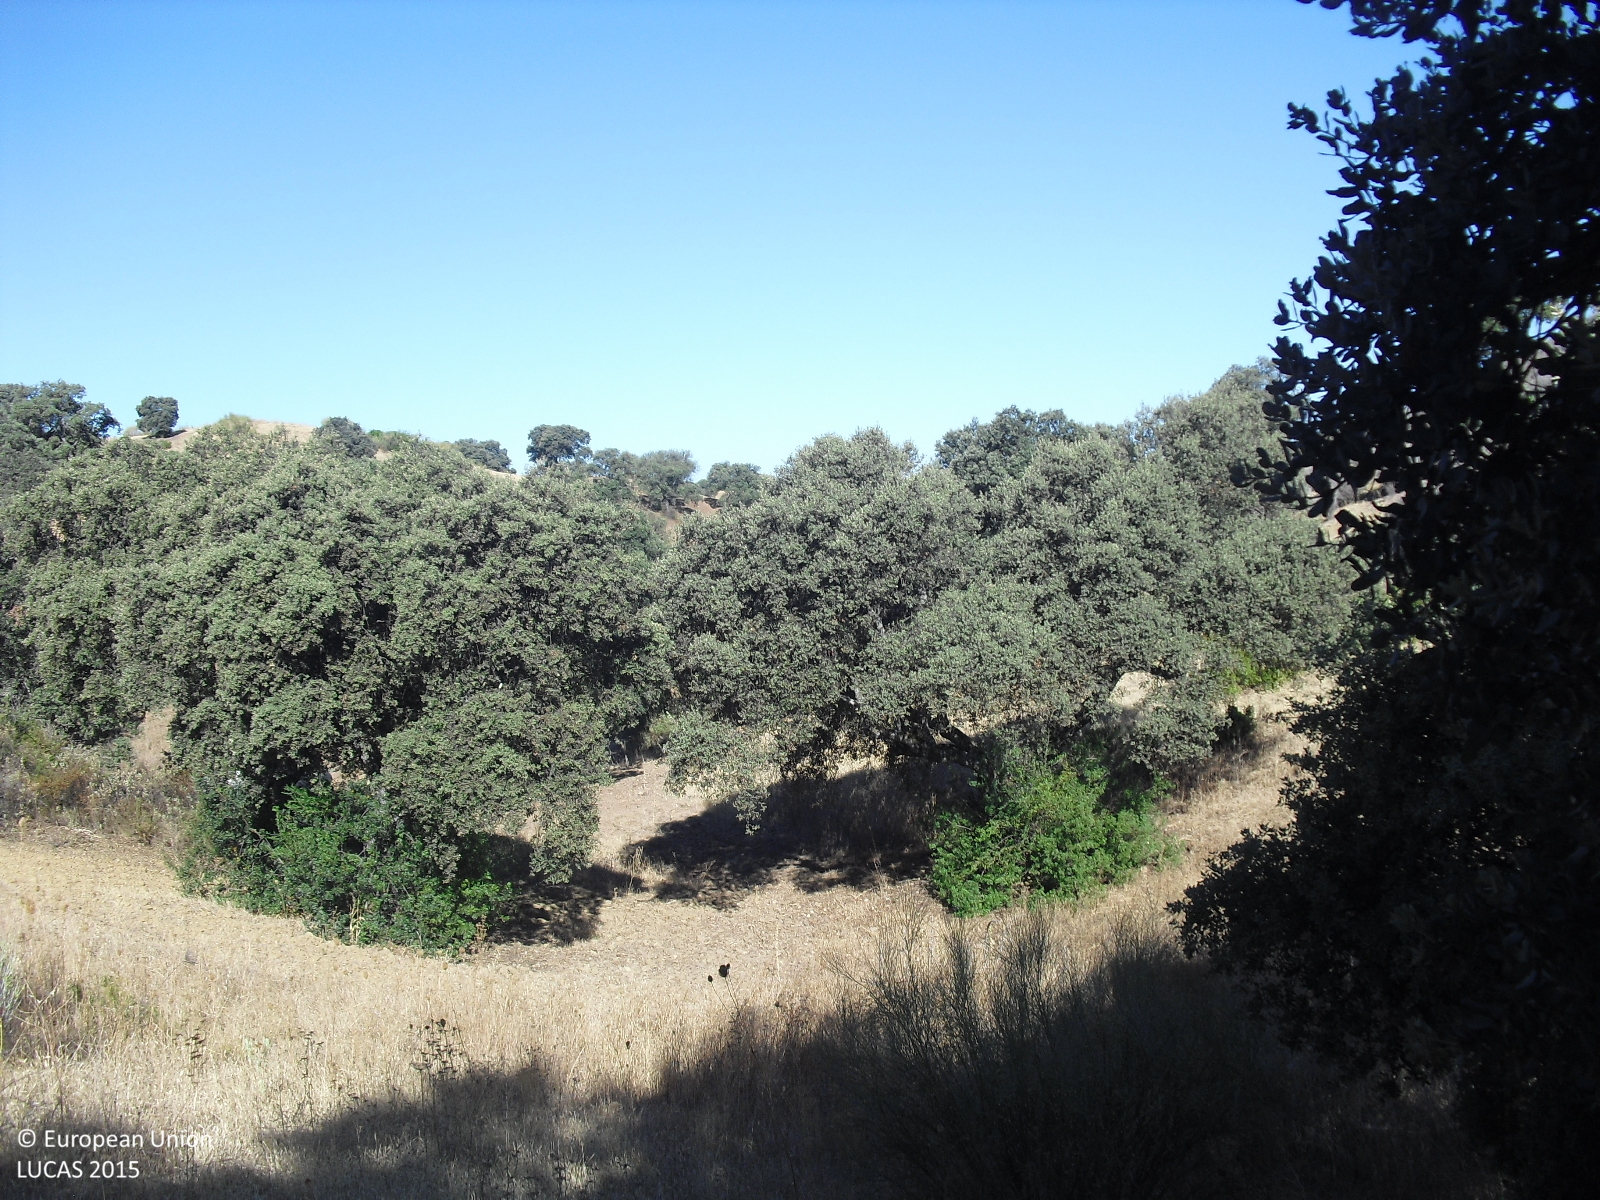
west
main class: Woodland
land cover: Broadleaved woodland
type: broadleaved evergreen forest
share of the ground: 25 - 50 %
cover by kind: herbaceous plants 65 %, broadleaved forest trees 30 %, shrubs 5 %
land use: Forestry
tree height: > 5 m
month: July
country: ES
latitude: 37.0236
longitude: -5.3731
